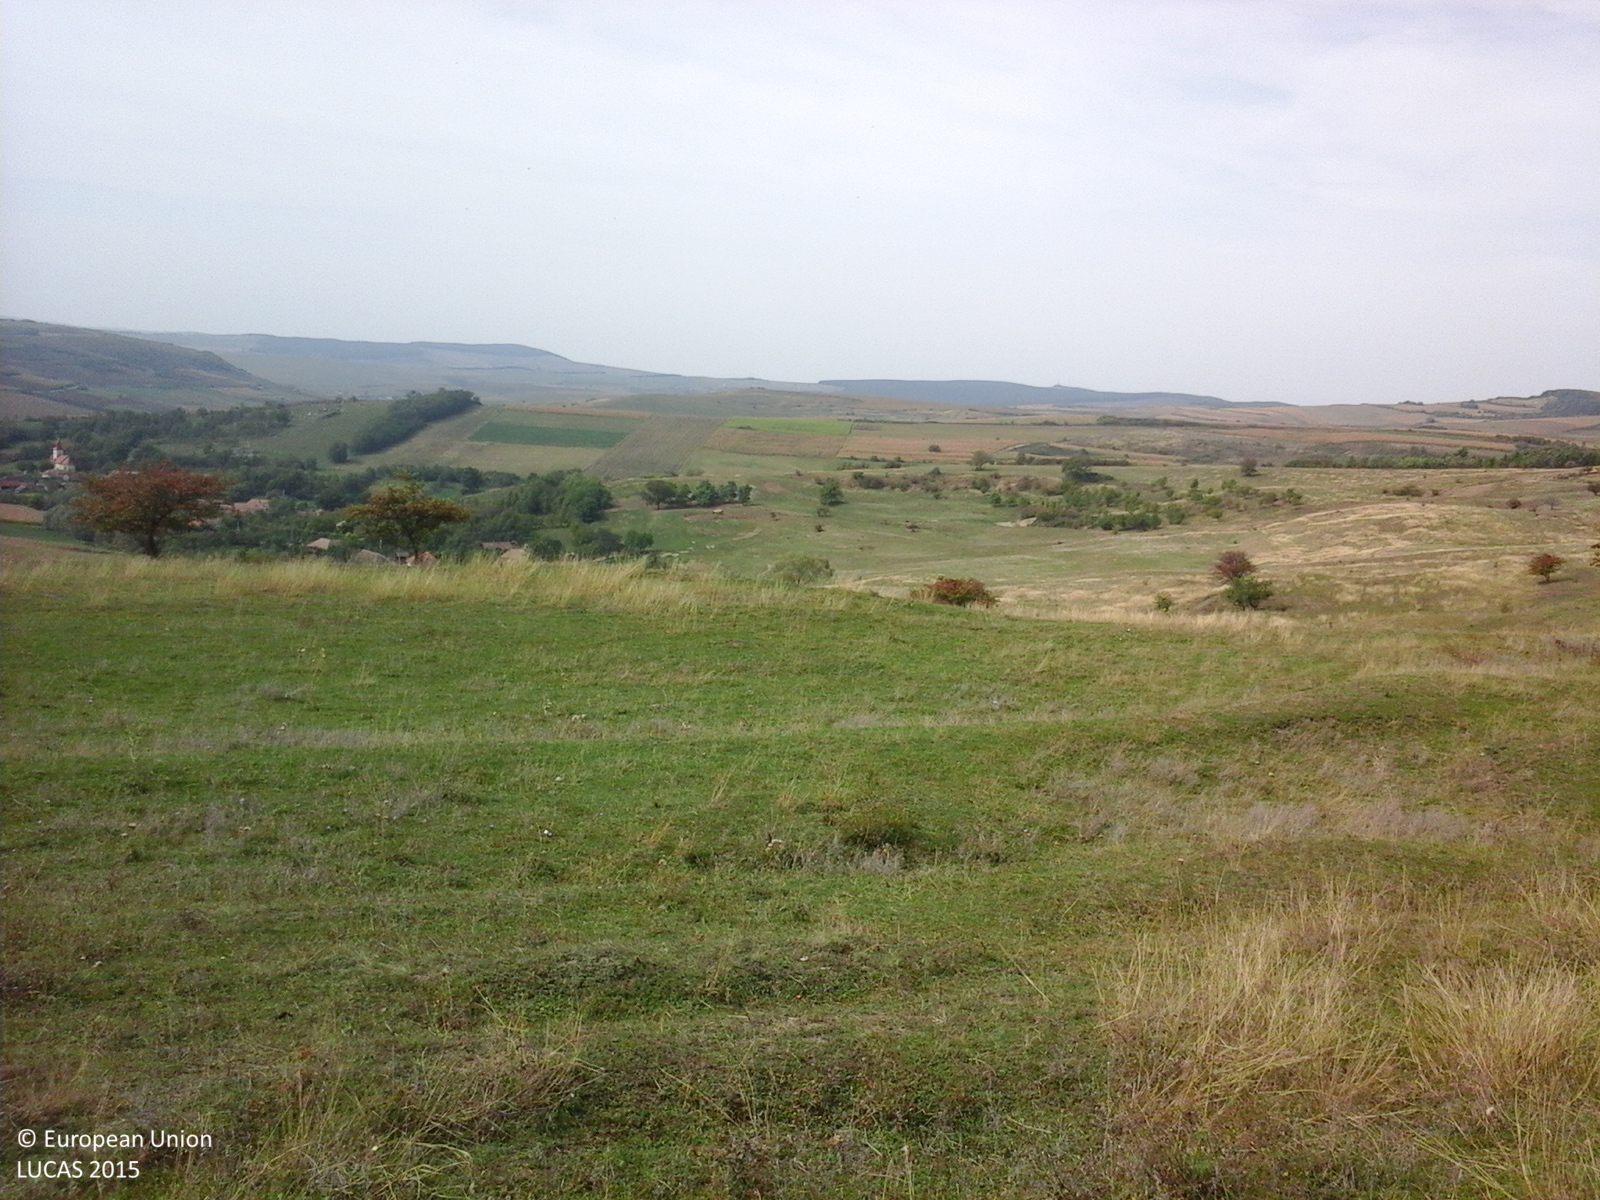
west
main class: Grassland
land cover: Grassland without tree/shrub cover
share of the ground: > 75 %
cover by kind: herbaceous plants 100 %
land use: Agriculture (excluding fallow land and kitchen gardens)
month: September
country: RO
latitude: 46.8762
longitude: 24.2148
